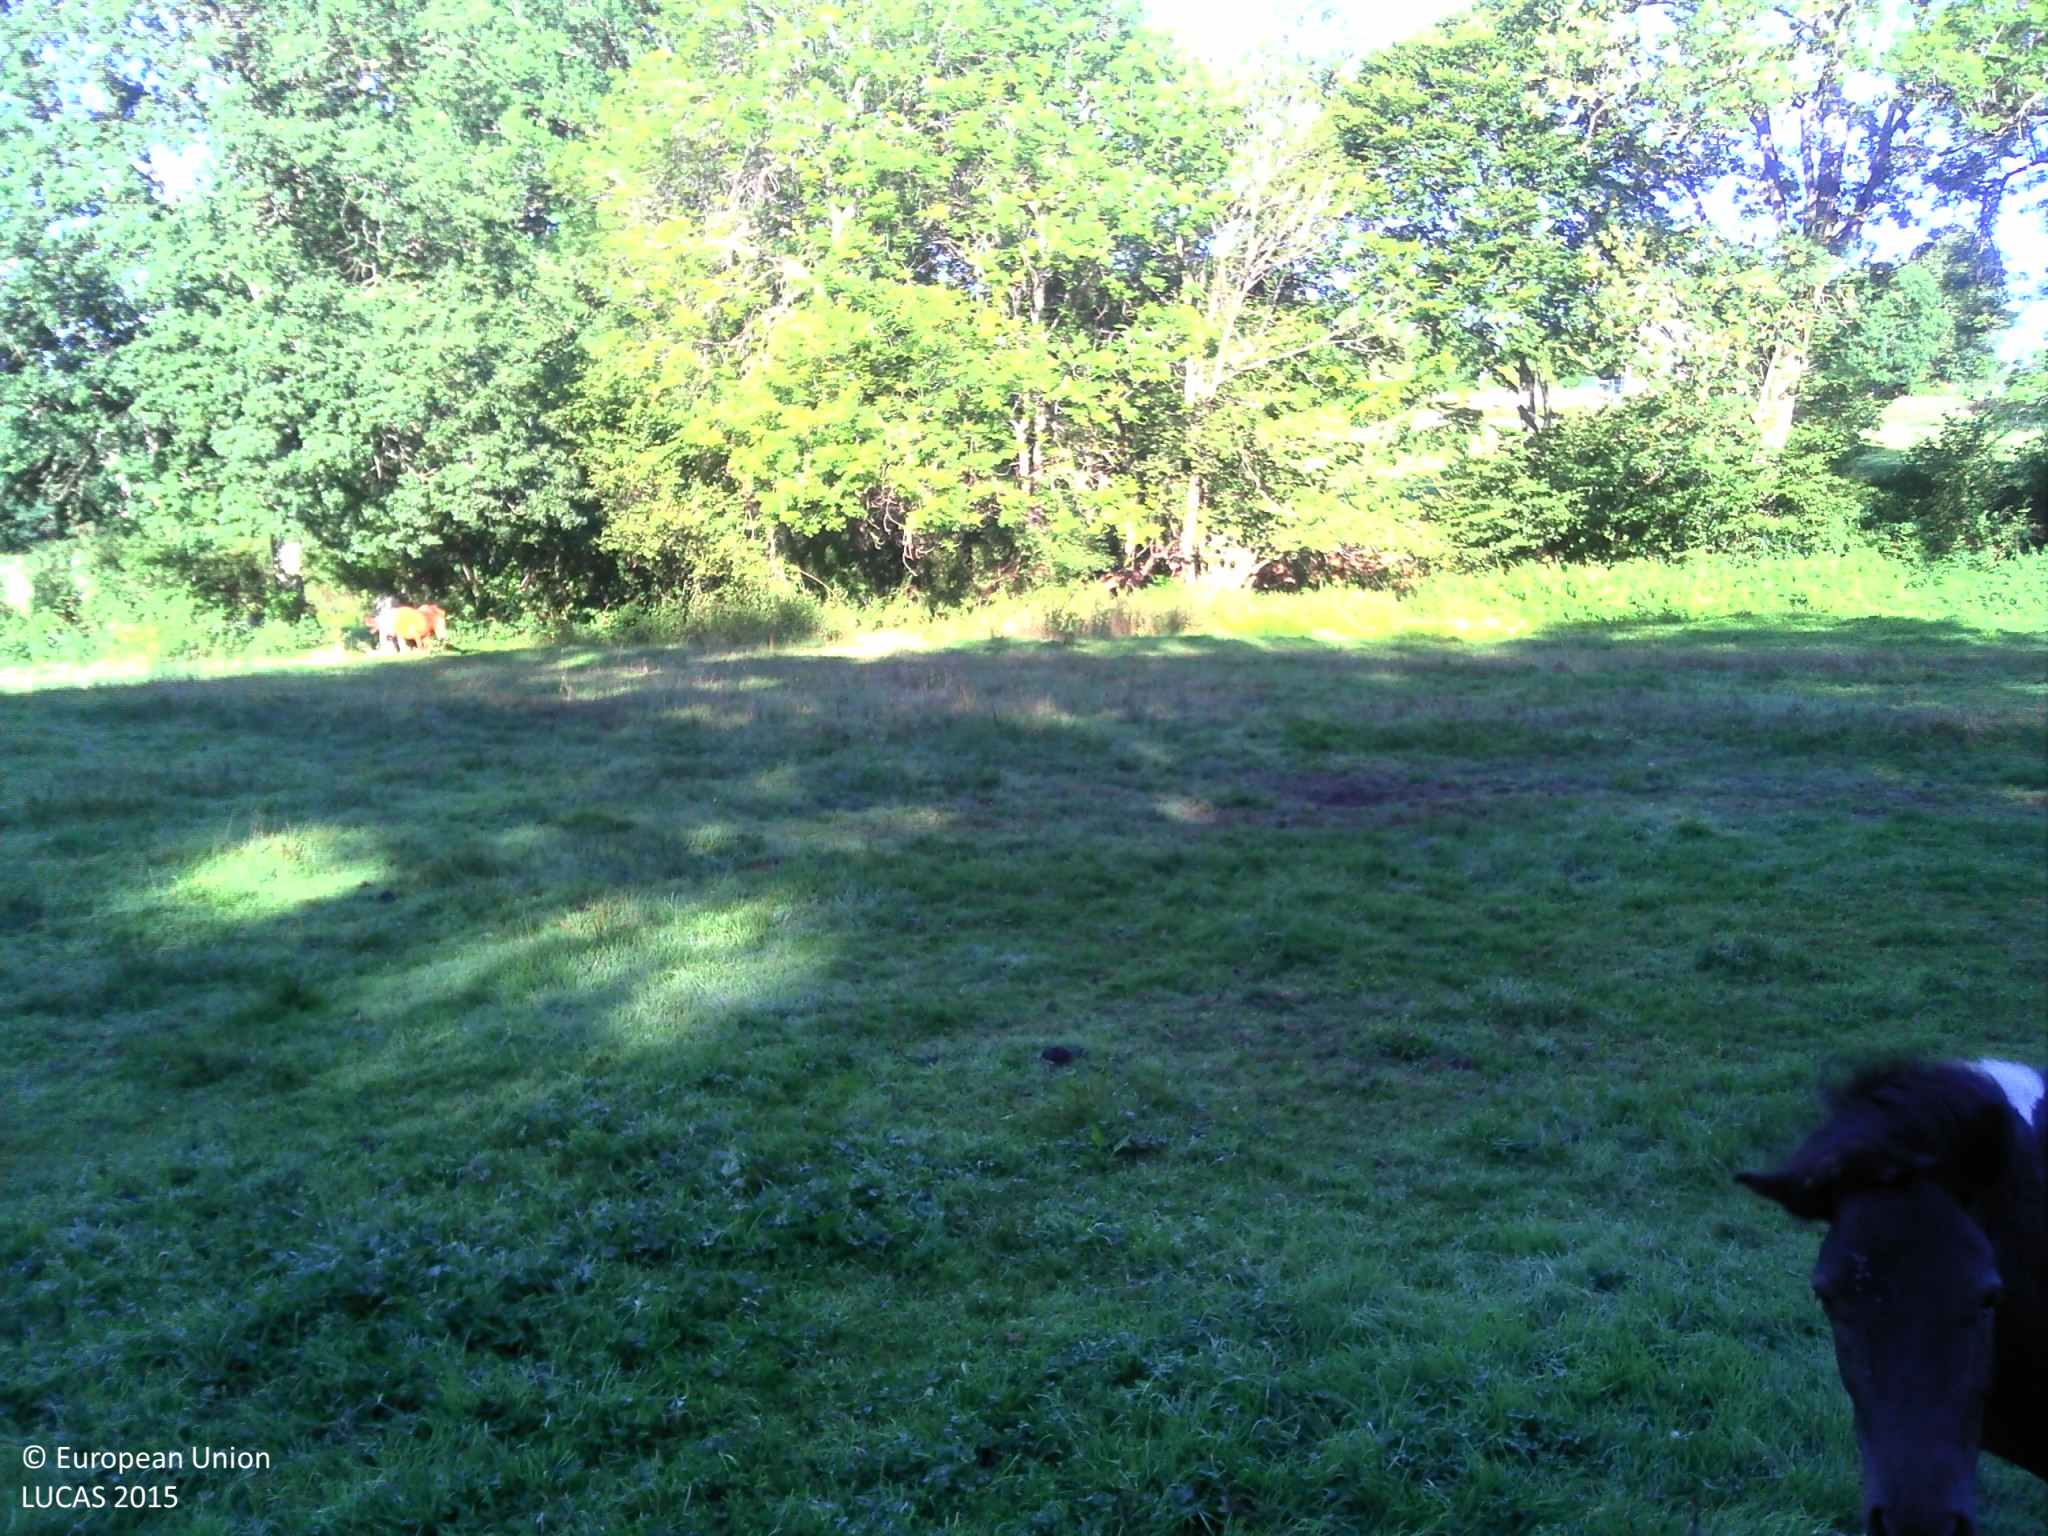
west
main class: Grassland
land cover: Grassland without tree/shrub cover
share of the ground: > 75 %
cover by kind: herbaceous plants 95 %, shrubs 5 %
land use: Agriculture (excluding fallow land and kitchen gardens)
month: August
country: FR
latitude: 45.8426
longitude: 2.3612
